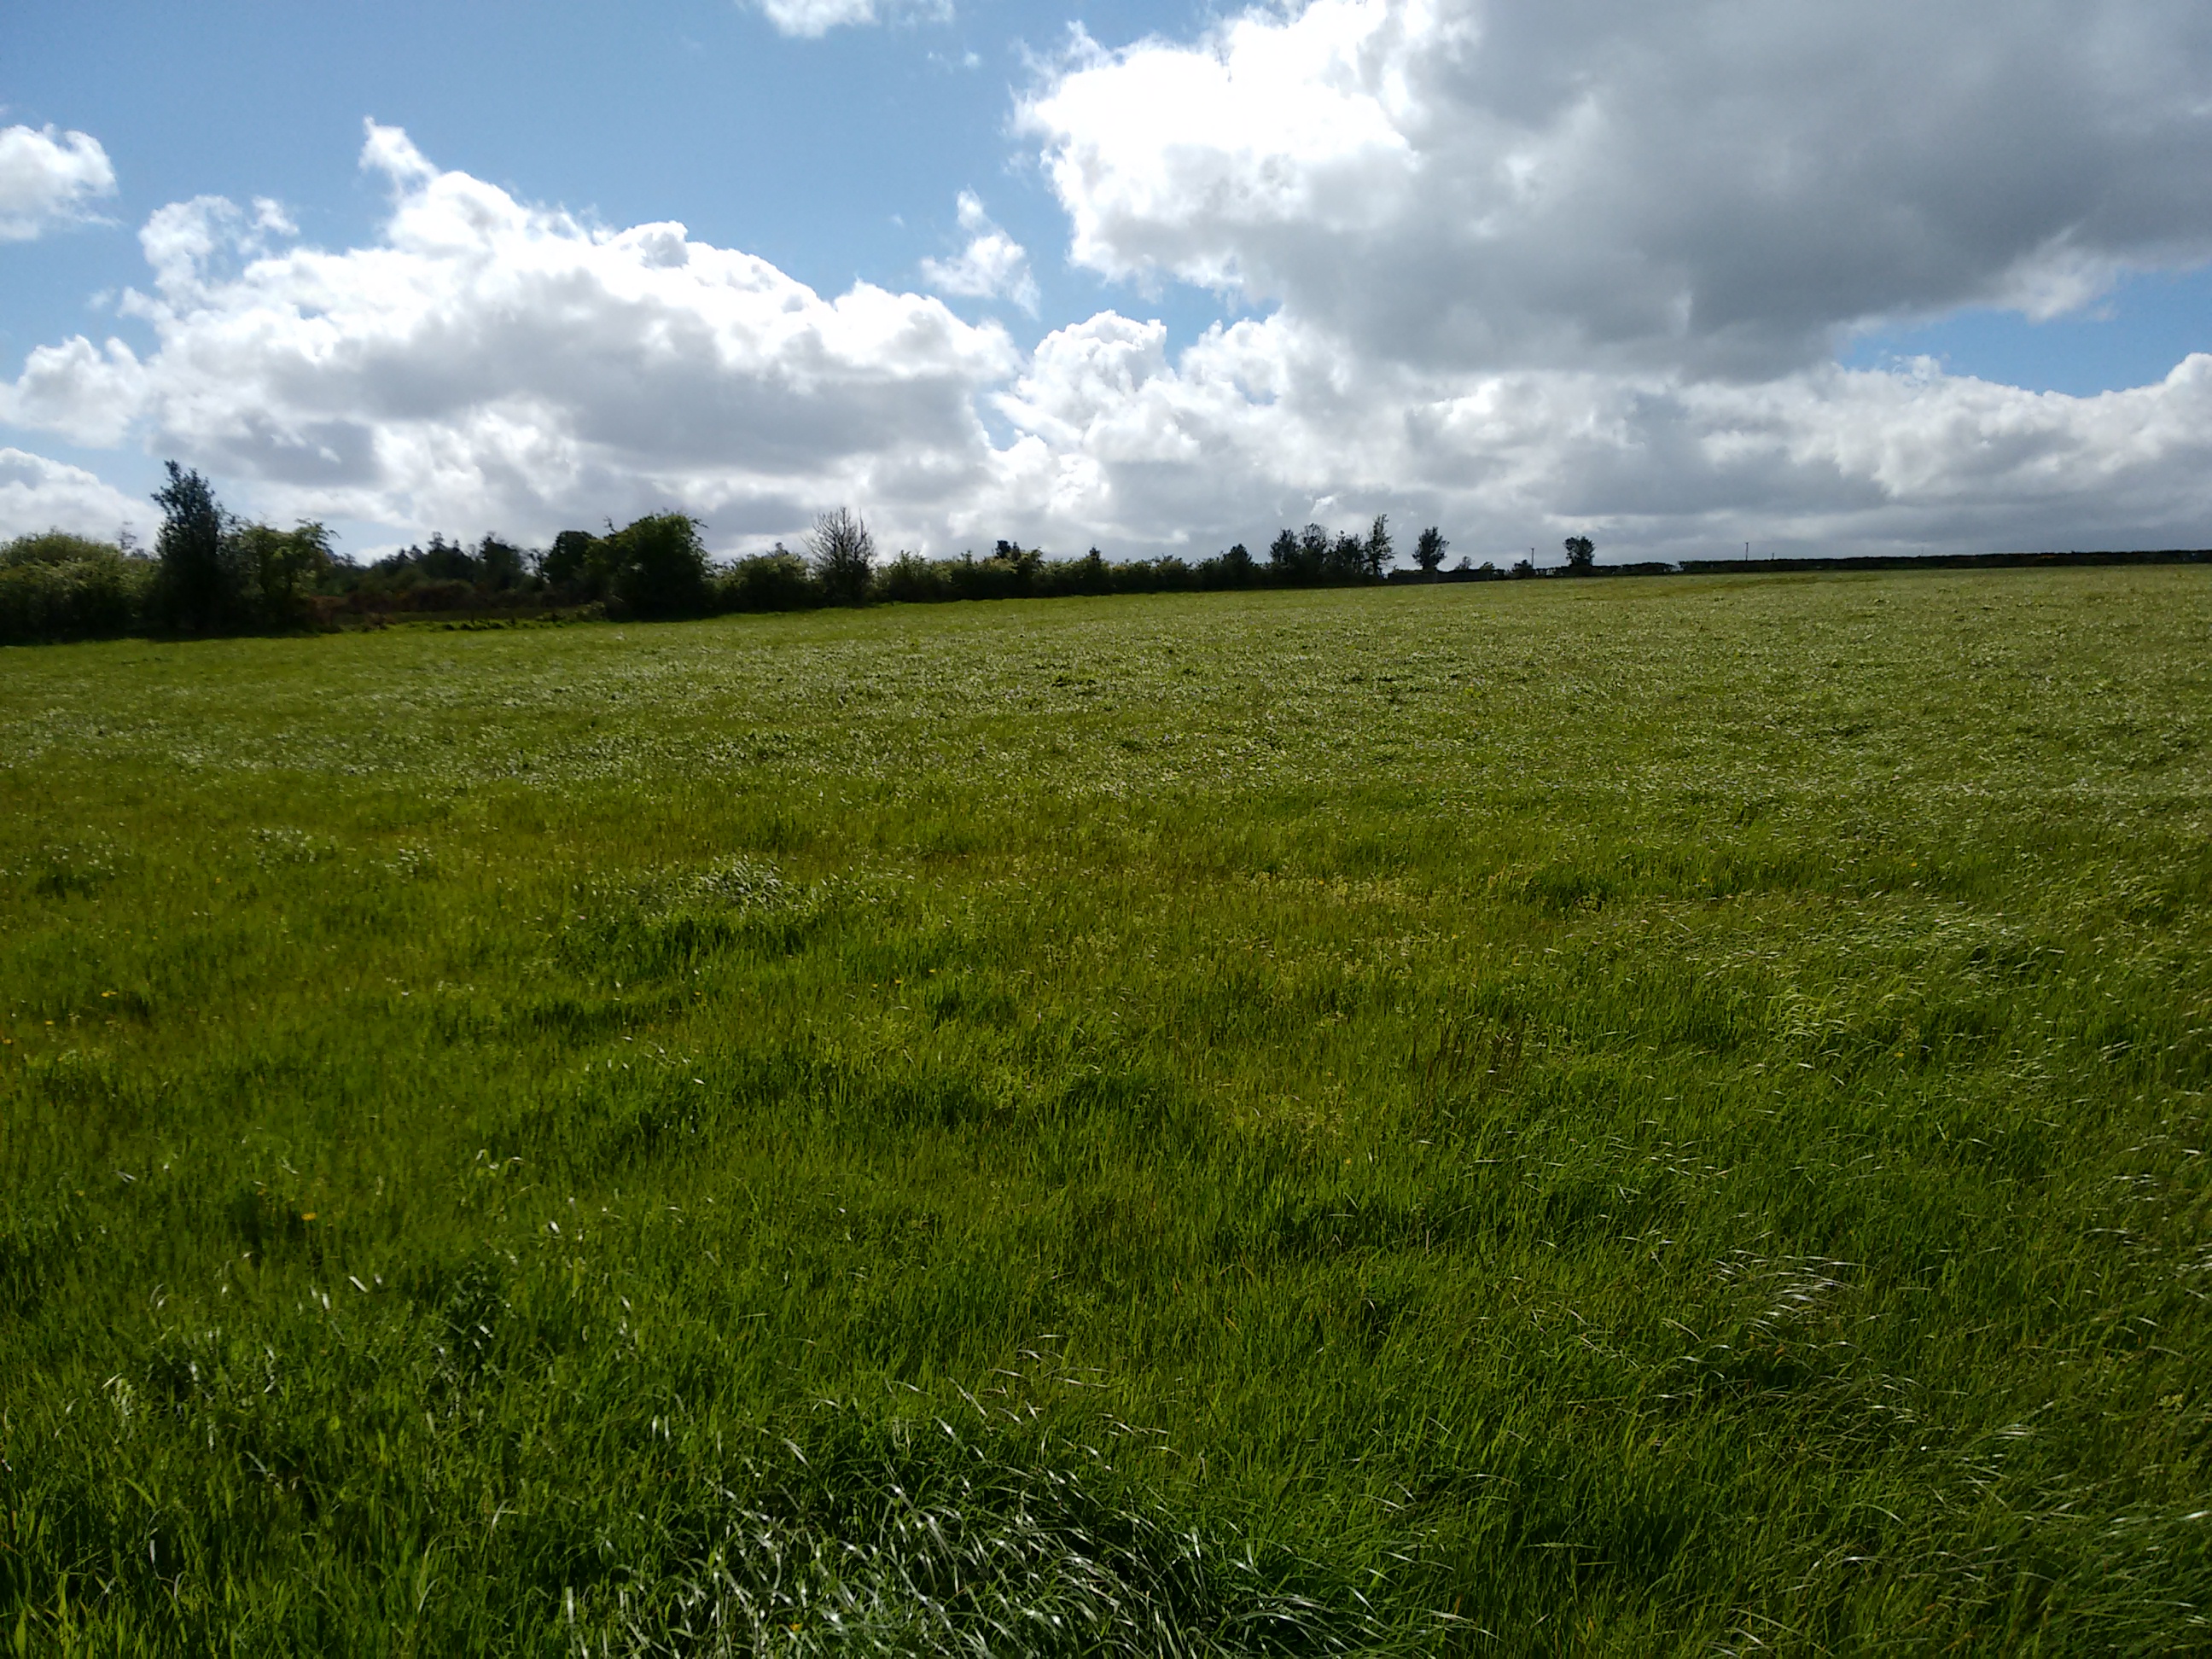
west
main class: Grassland
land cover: Grassland without tree/shrub cover
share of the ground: > 75 %
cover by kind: herbaceous plants 100 %
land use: Agriculture (excluding fallow land and kitchen gardens)
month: June
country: GB
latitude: 54.9114
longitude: -7.0003
